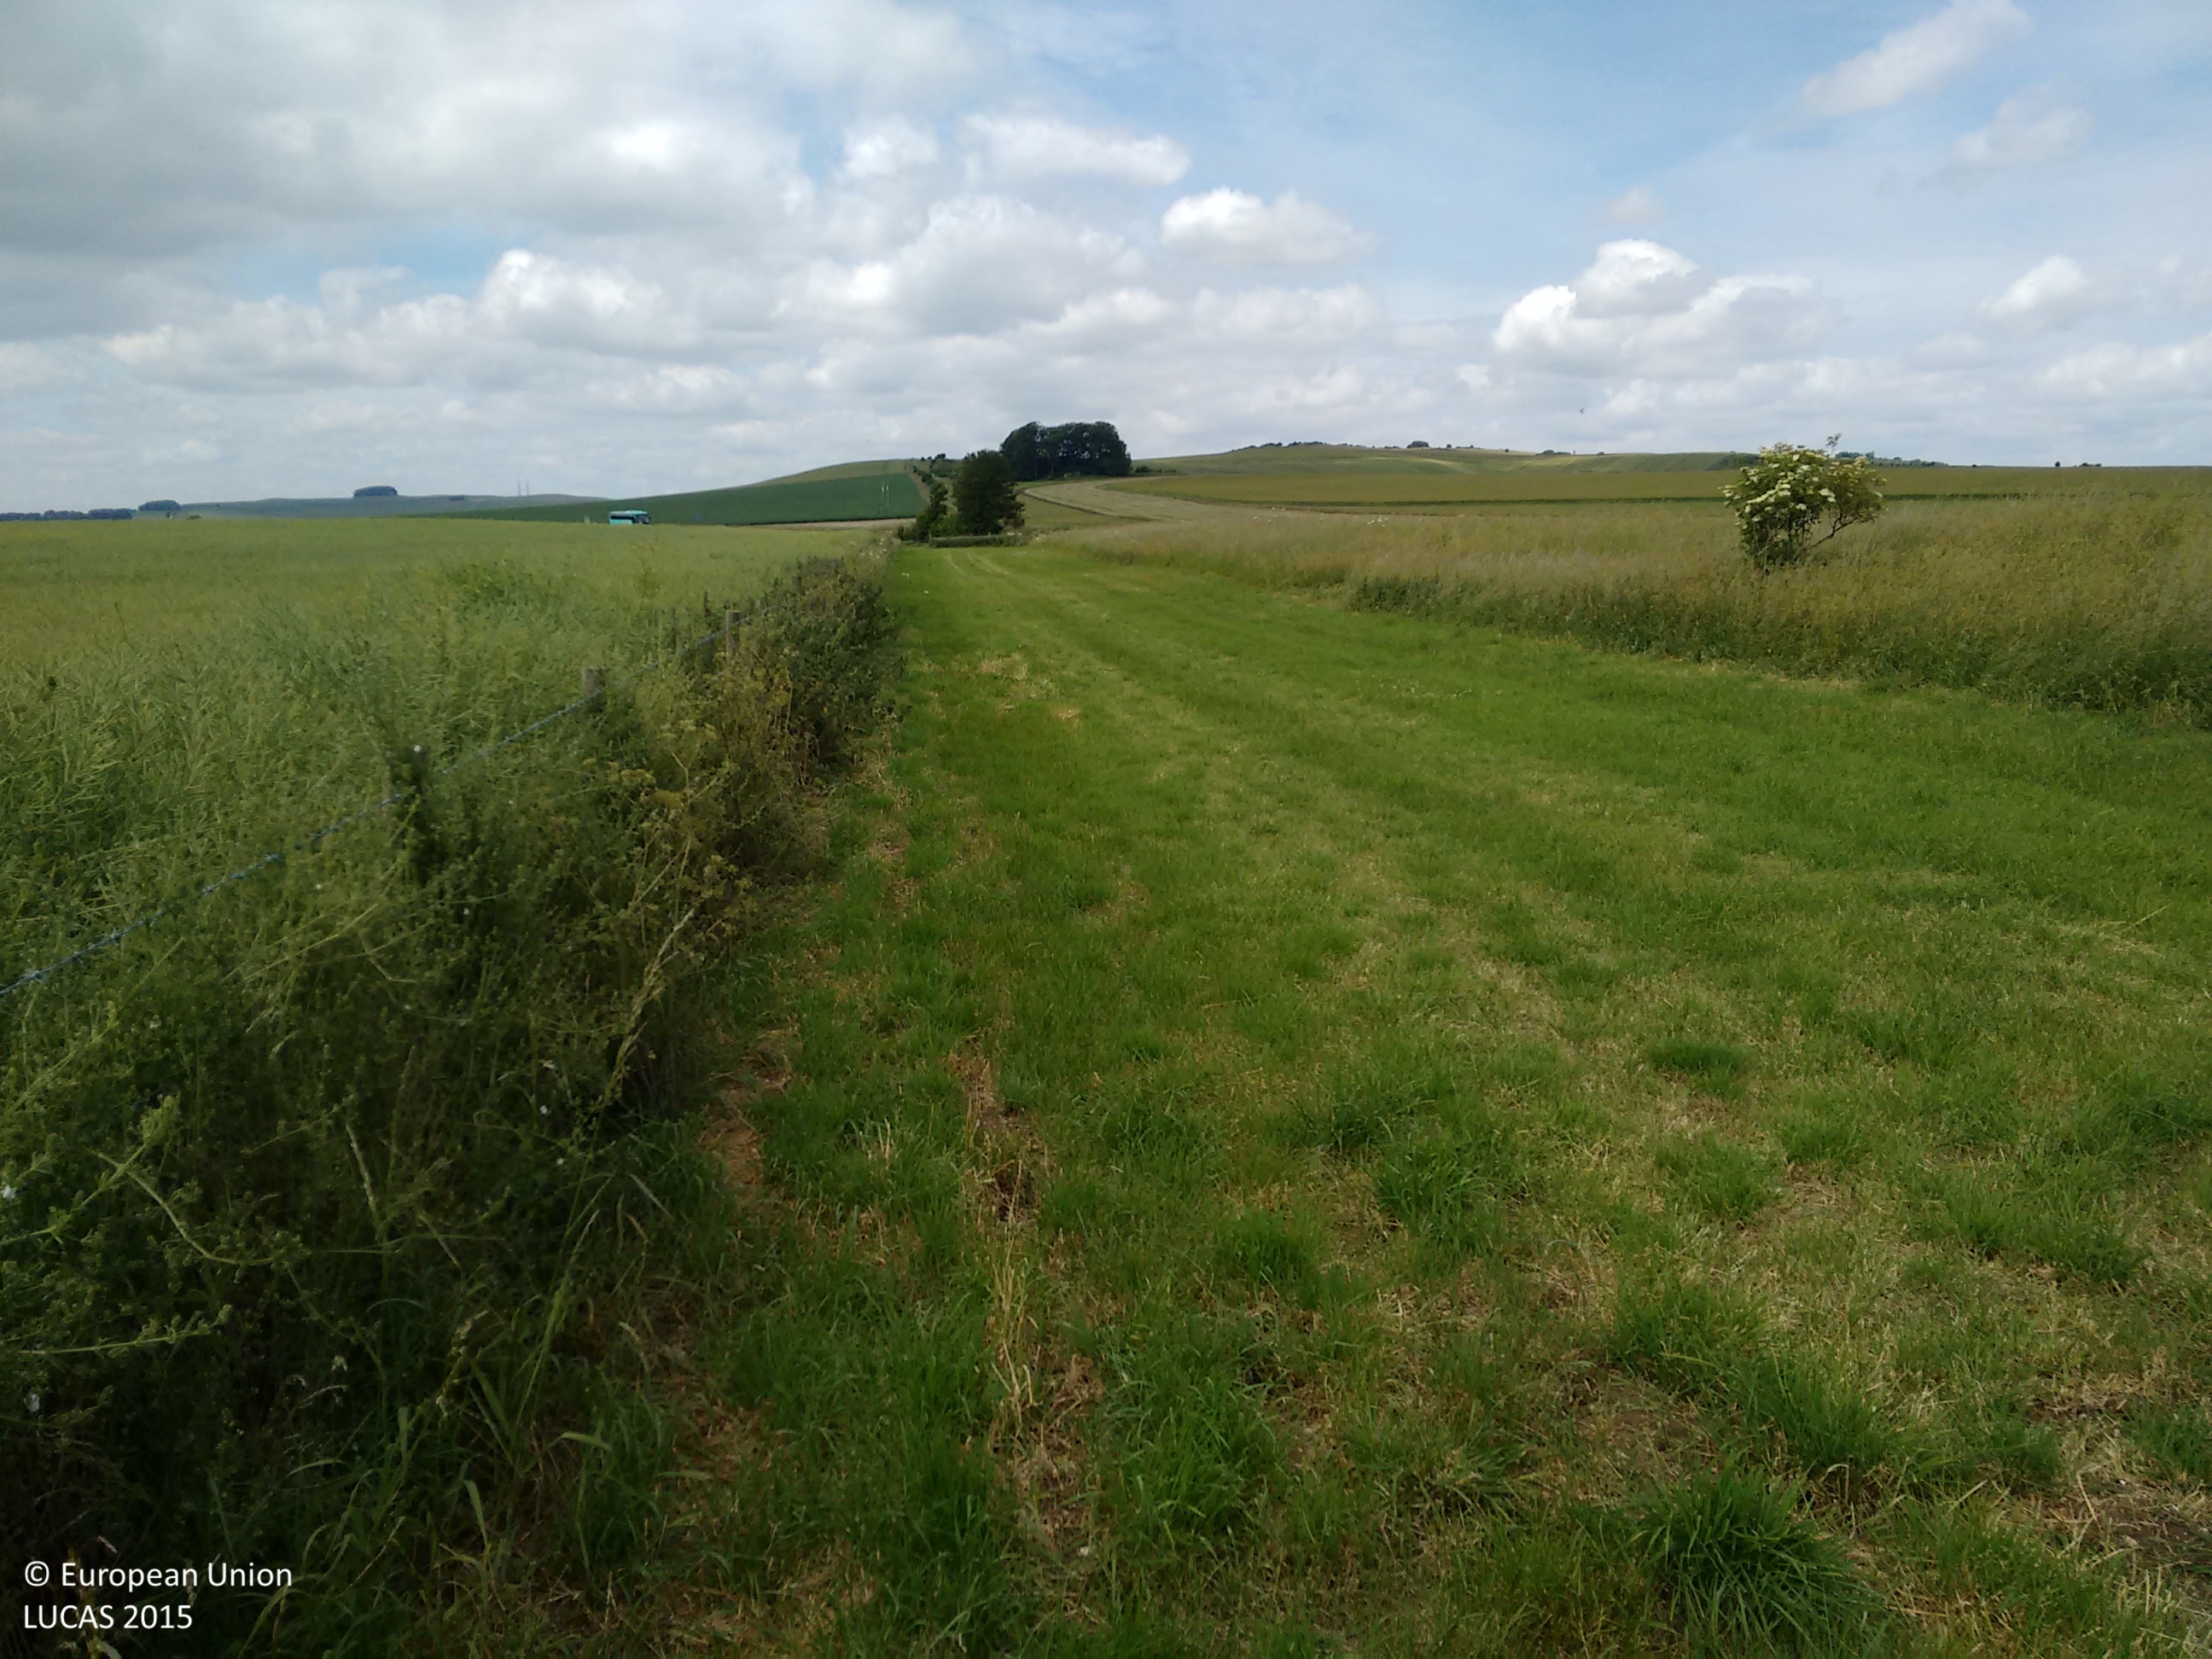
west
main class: Cropland
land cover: Rape and turnip rape
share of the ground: > 75 %
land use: Agriculture (excluding fallow land and kitchen gardens)
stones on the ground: 25 - 50 %
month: June
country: GB
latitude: 51.4138
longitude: -1.8902
